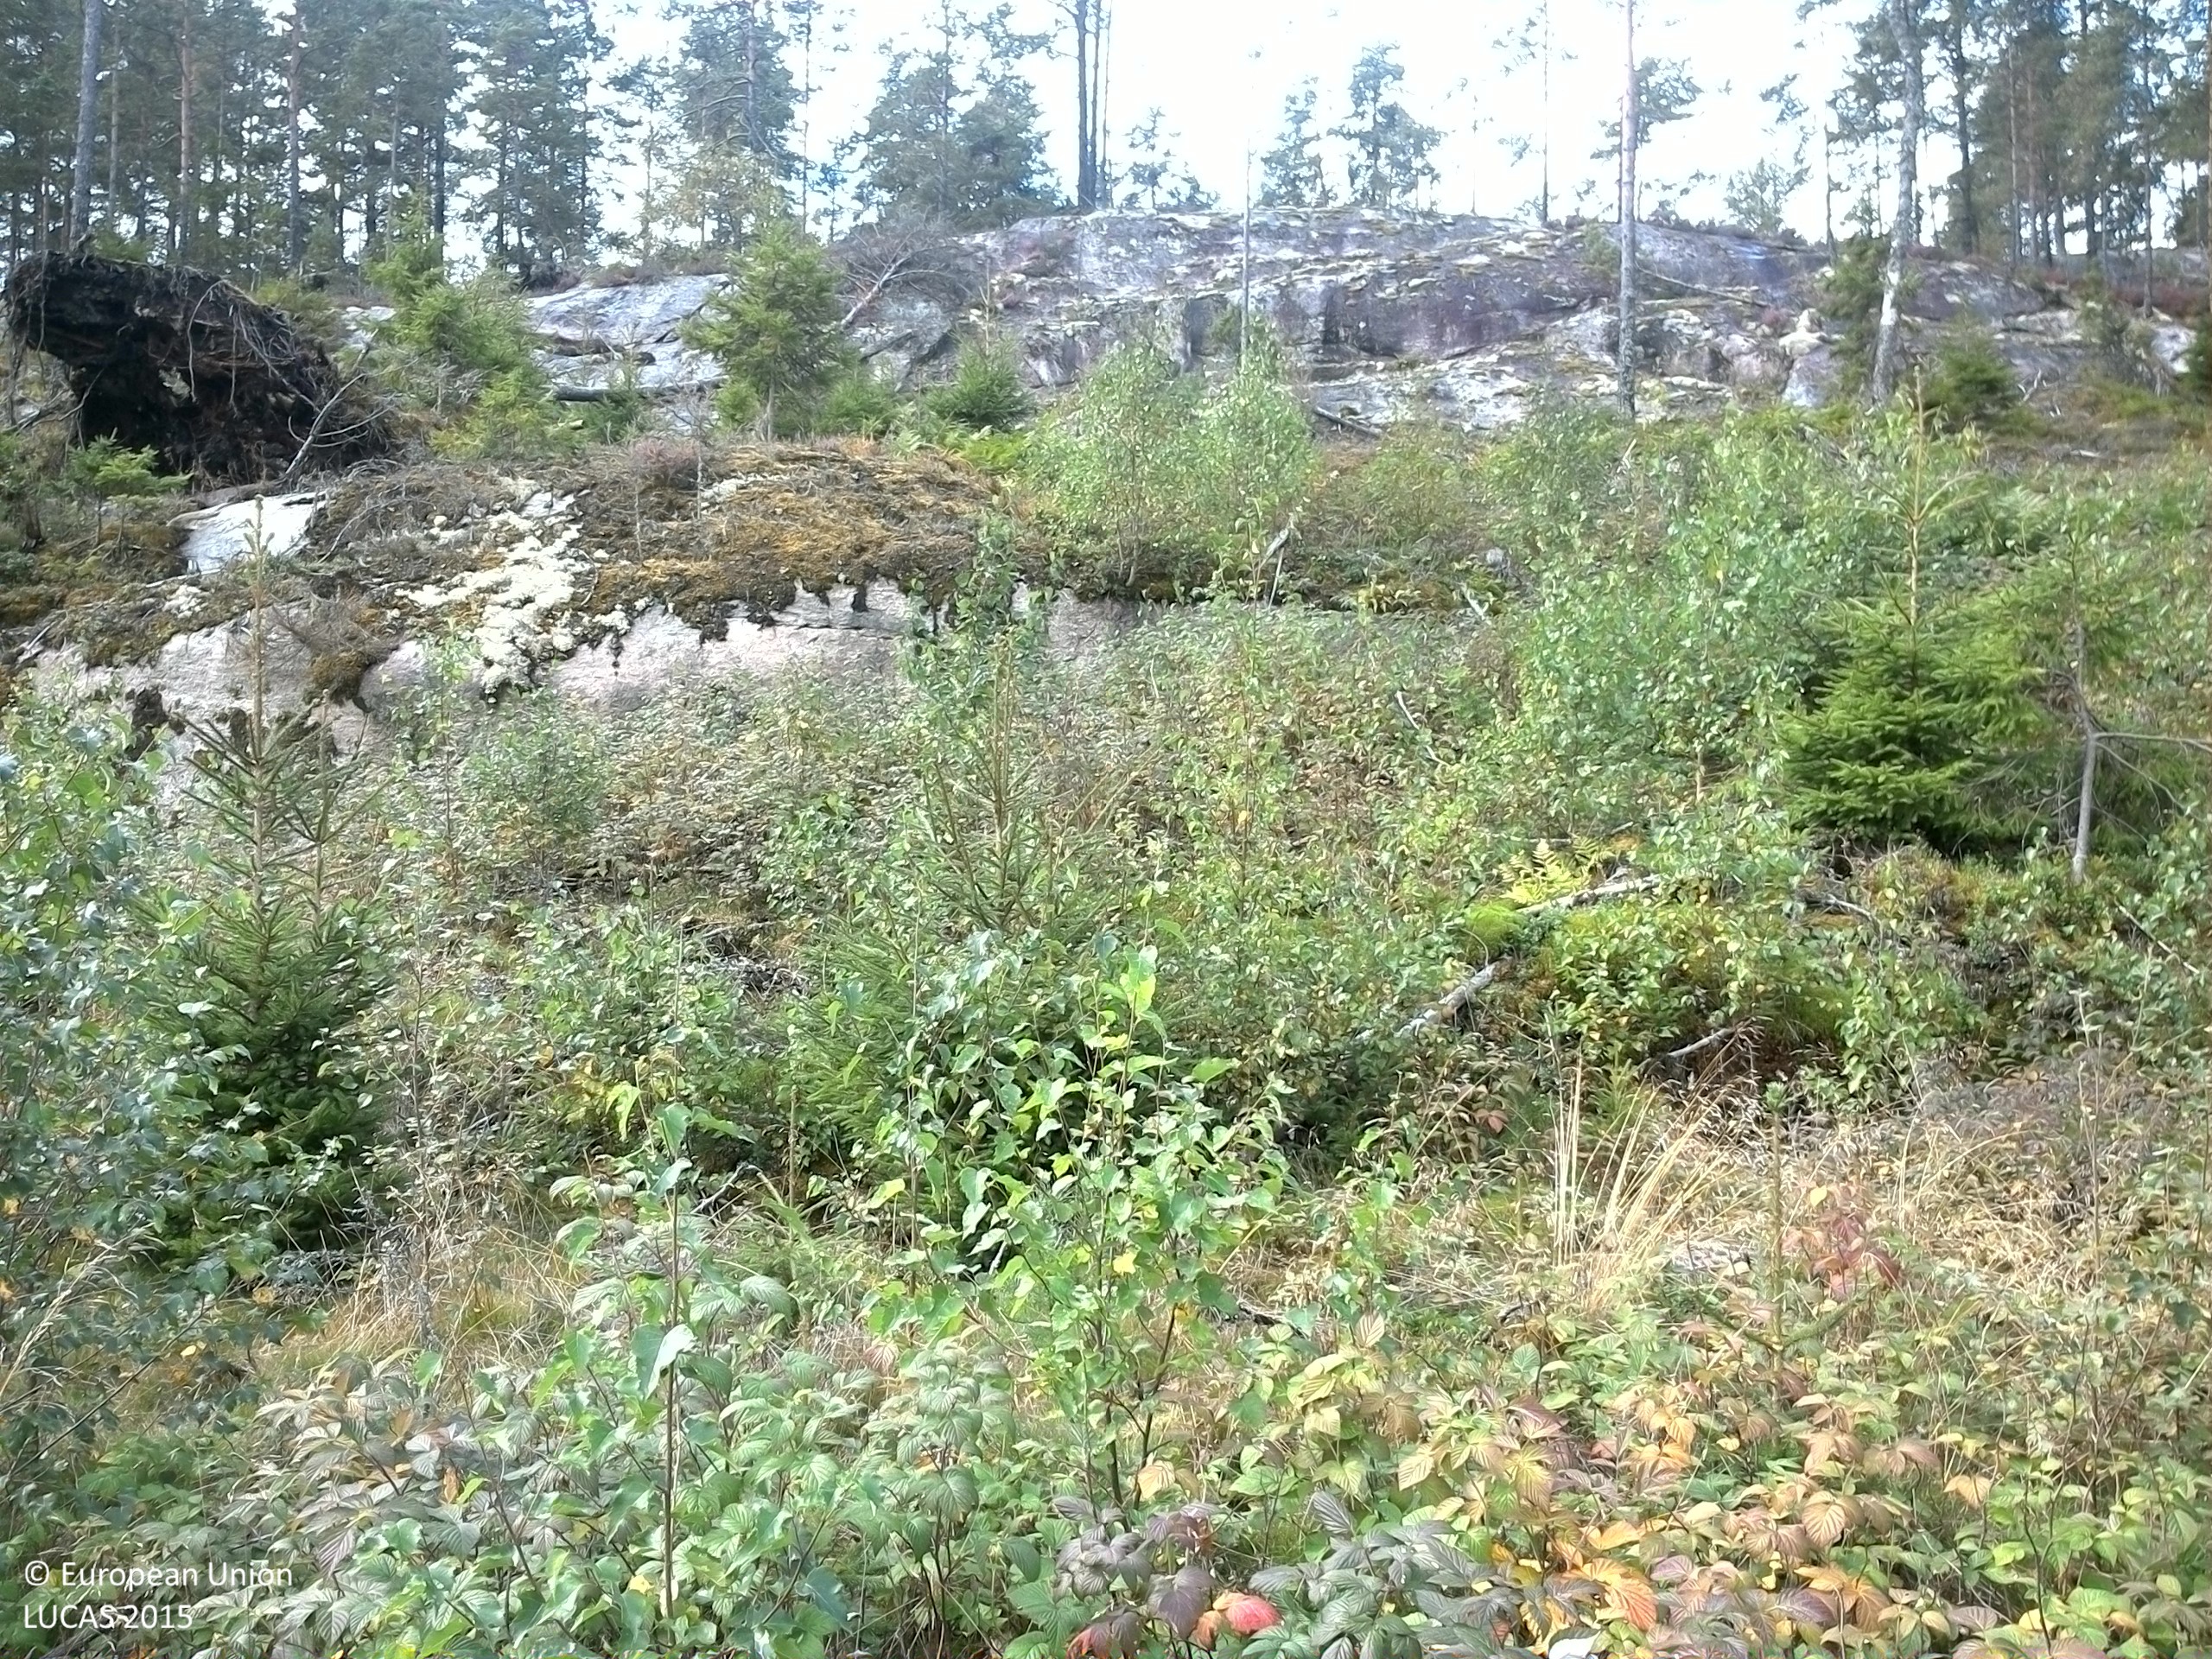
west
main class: Woodland
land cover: Spruce dominated mixed woodland
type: boreal forest
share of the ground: 25 - 50 %
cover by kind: broadleaved forest trees 30 %, shrubs 30 %, coniferous forest trees 20 %, herbaceous plants 10 %, consolidated bare surface 10 %
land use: Forestry
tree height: < 5 m
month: September
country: SE
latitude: 59.3206
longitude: 11.9805
